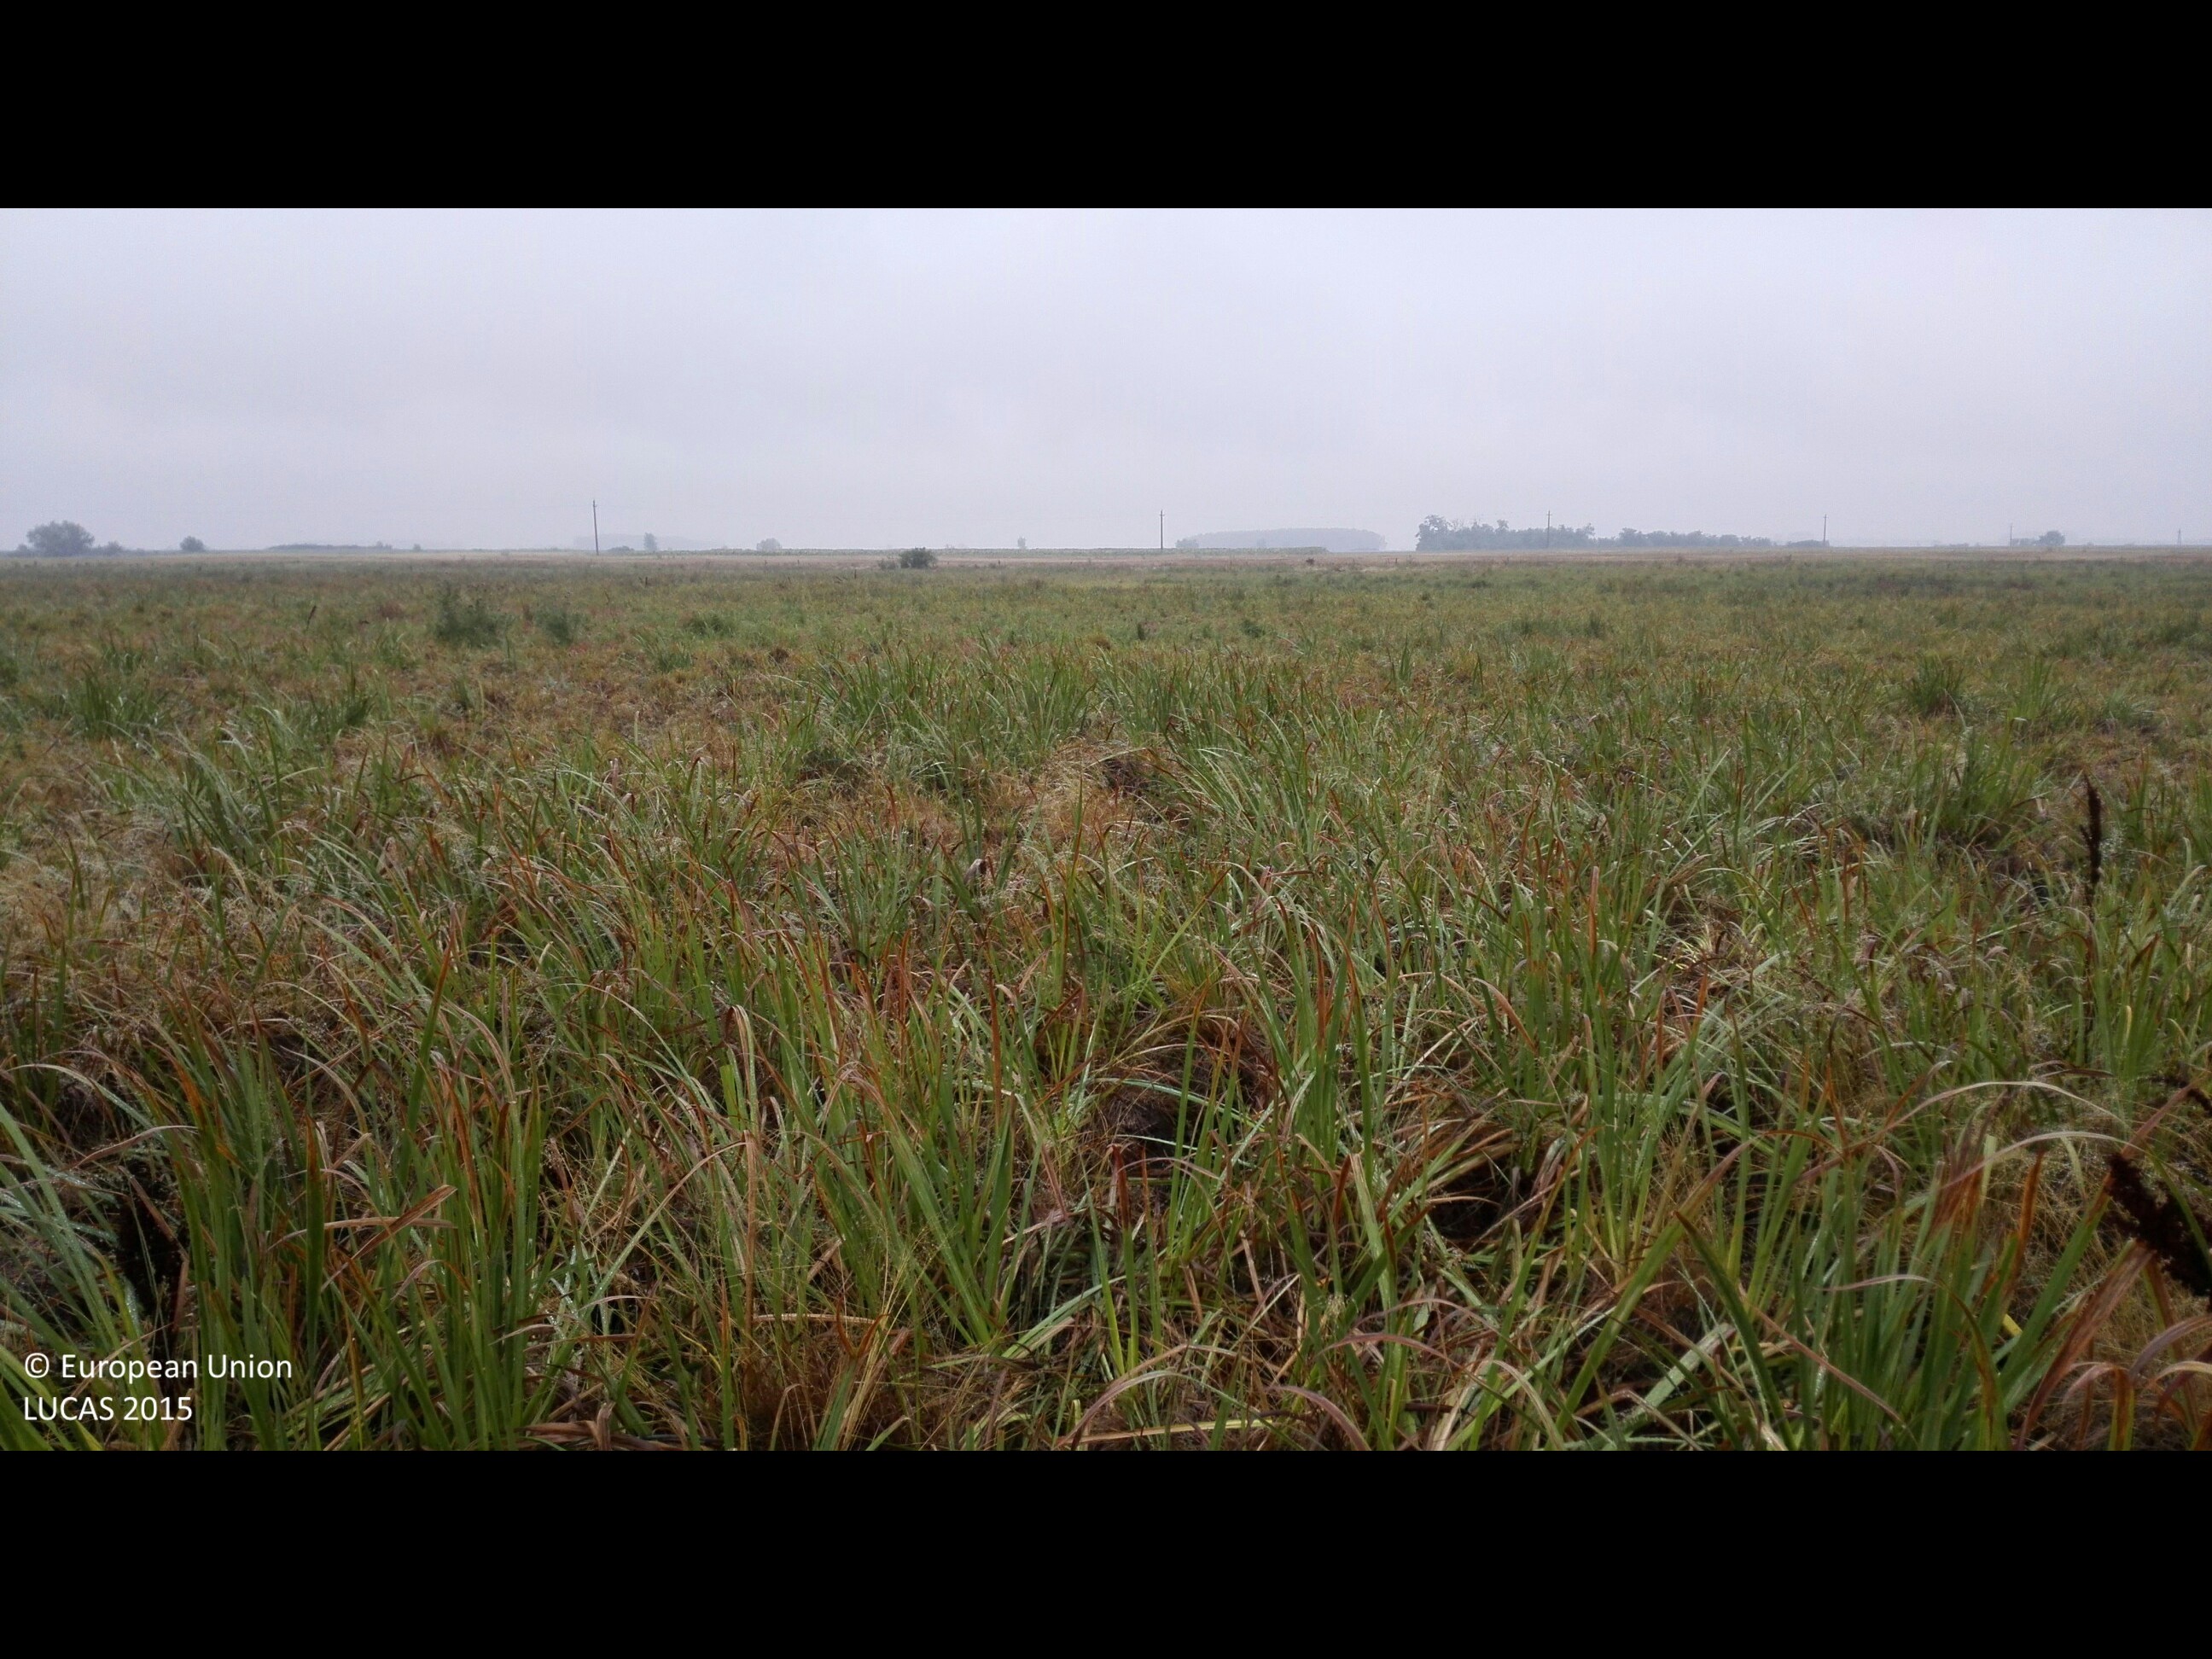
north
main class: Grassland
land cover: Spontaneously vegetated surfaces
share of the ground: > 75 %
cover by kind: herbaceous plants 100 %
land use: Agriculture (excluding fallow land and kitchen gardens)
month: August
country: HU
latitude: 47.2094
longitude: 21.5950
